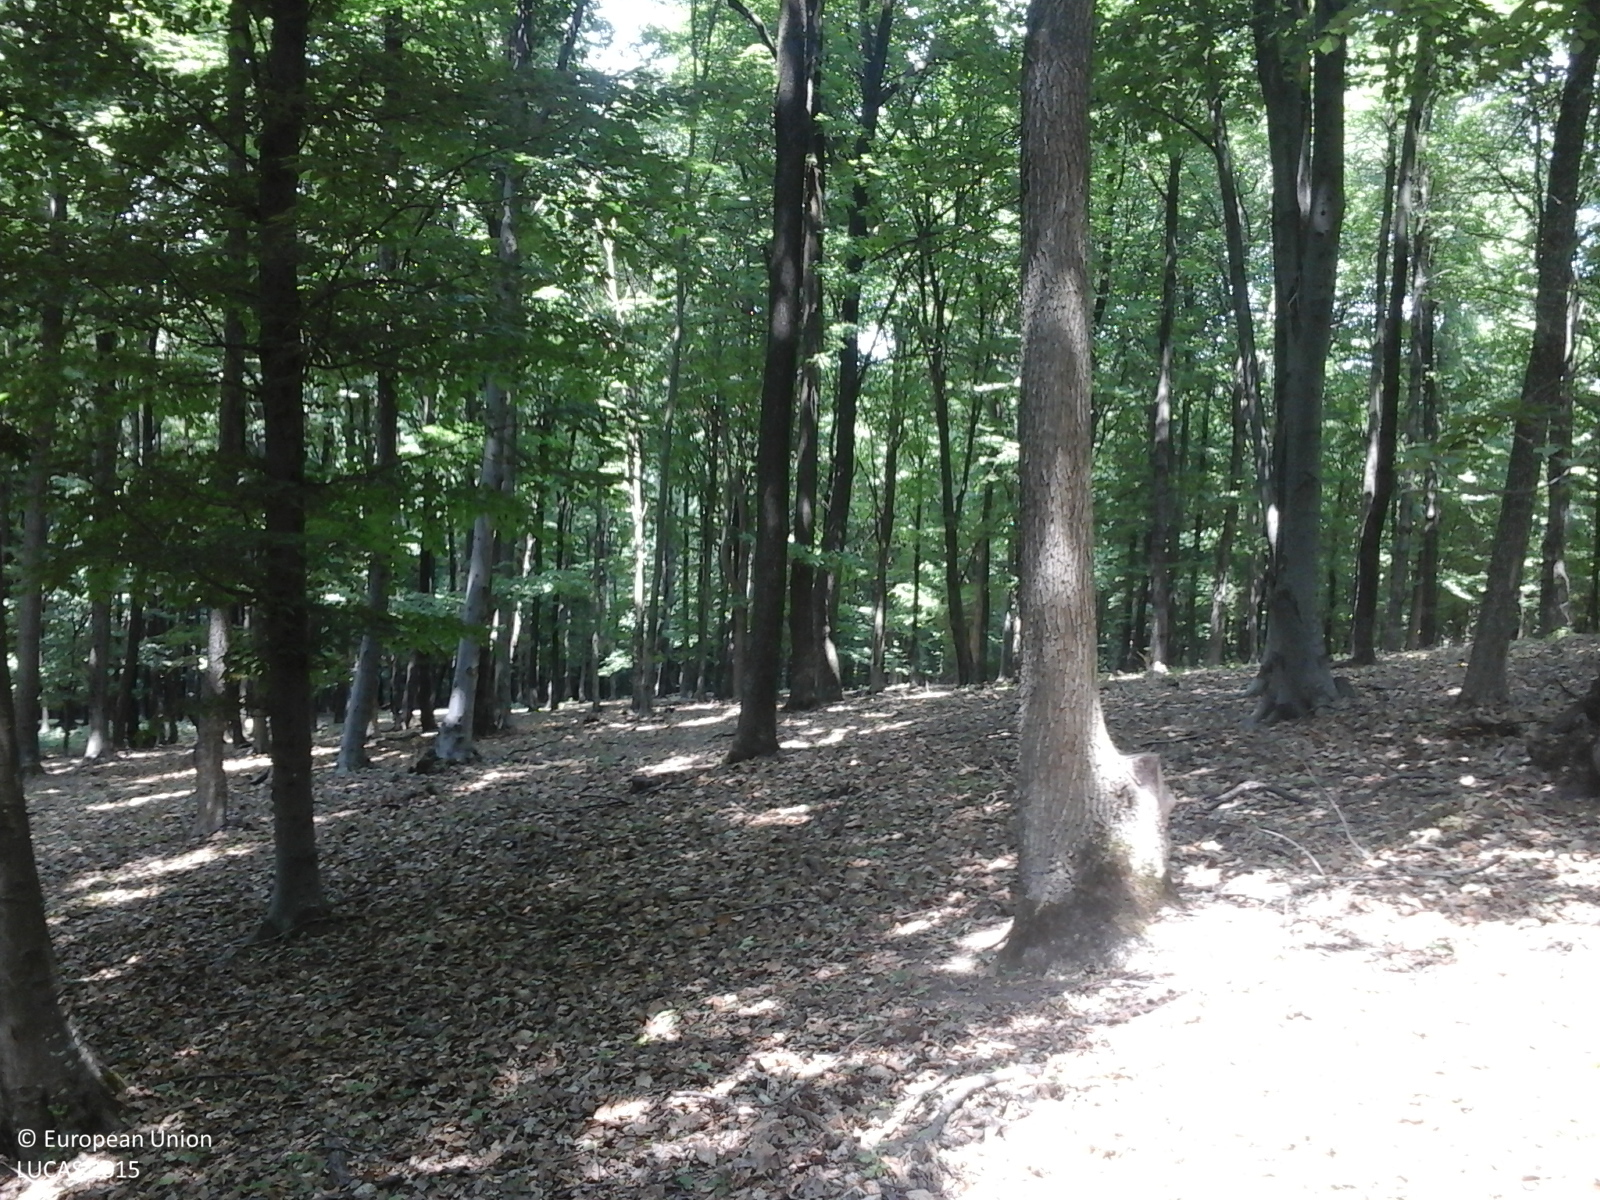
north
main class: Woodland
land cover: Broadleaved woodland
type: mesophytic deciduous forest
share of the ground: > 75 %
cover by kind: broadleaved forest trees 100 %
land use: Forestry
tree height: > 5 m
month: June
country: RO
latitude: 46.4057
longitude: 27.1528
